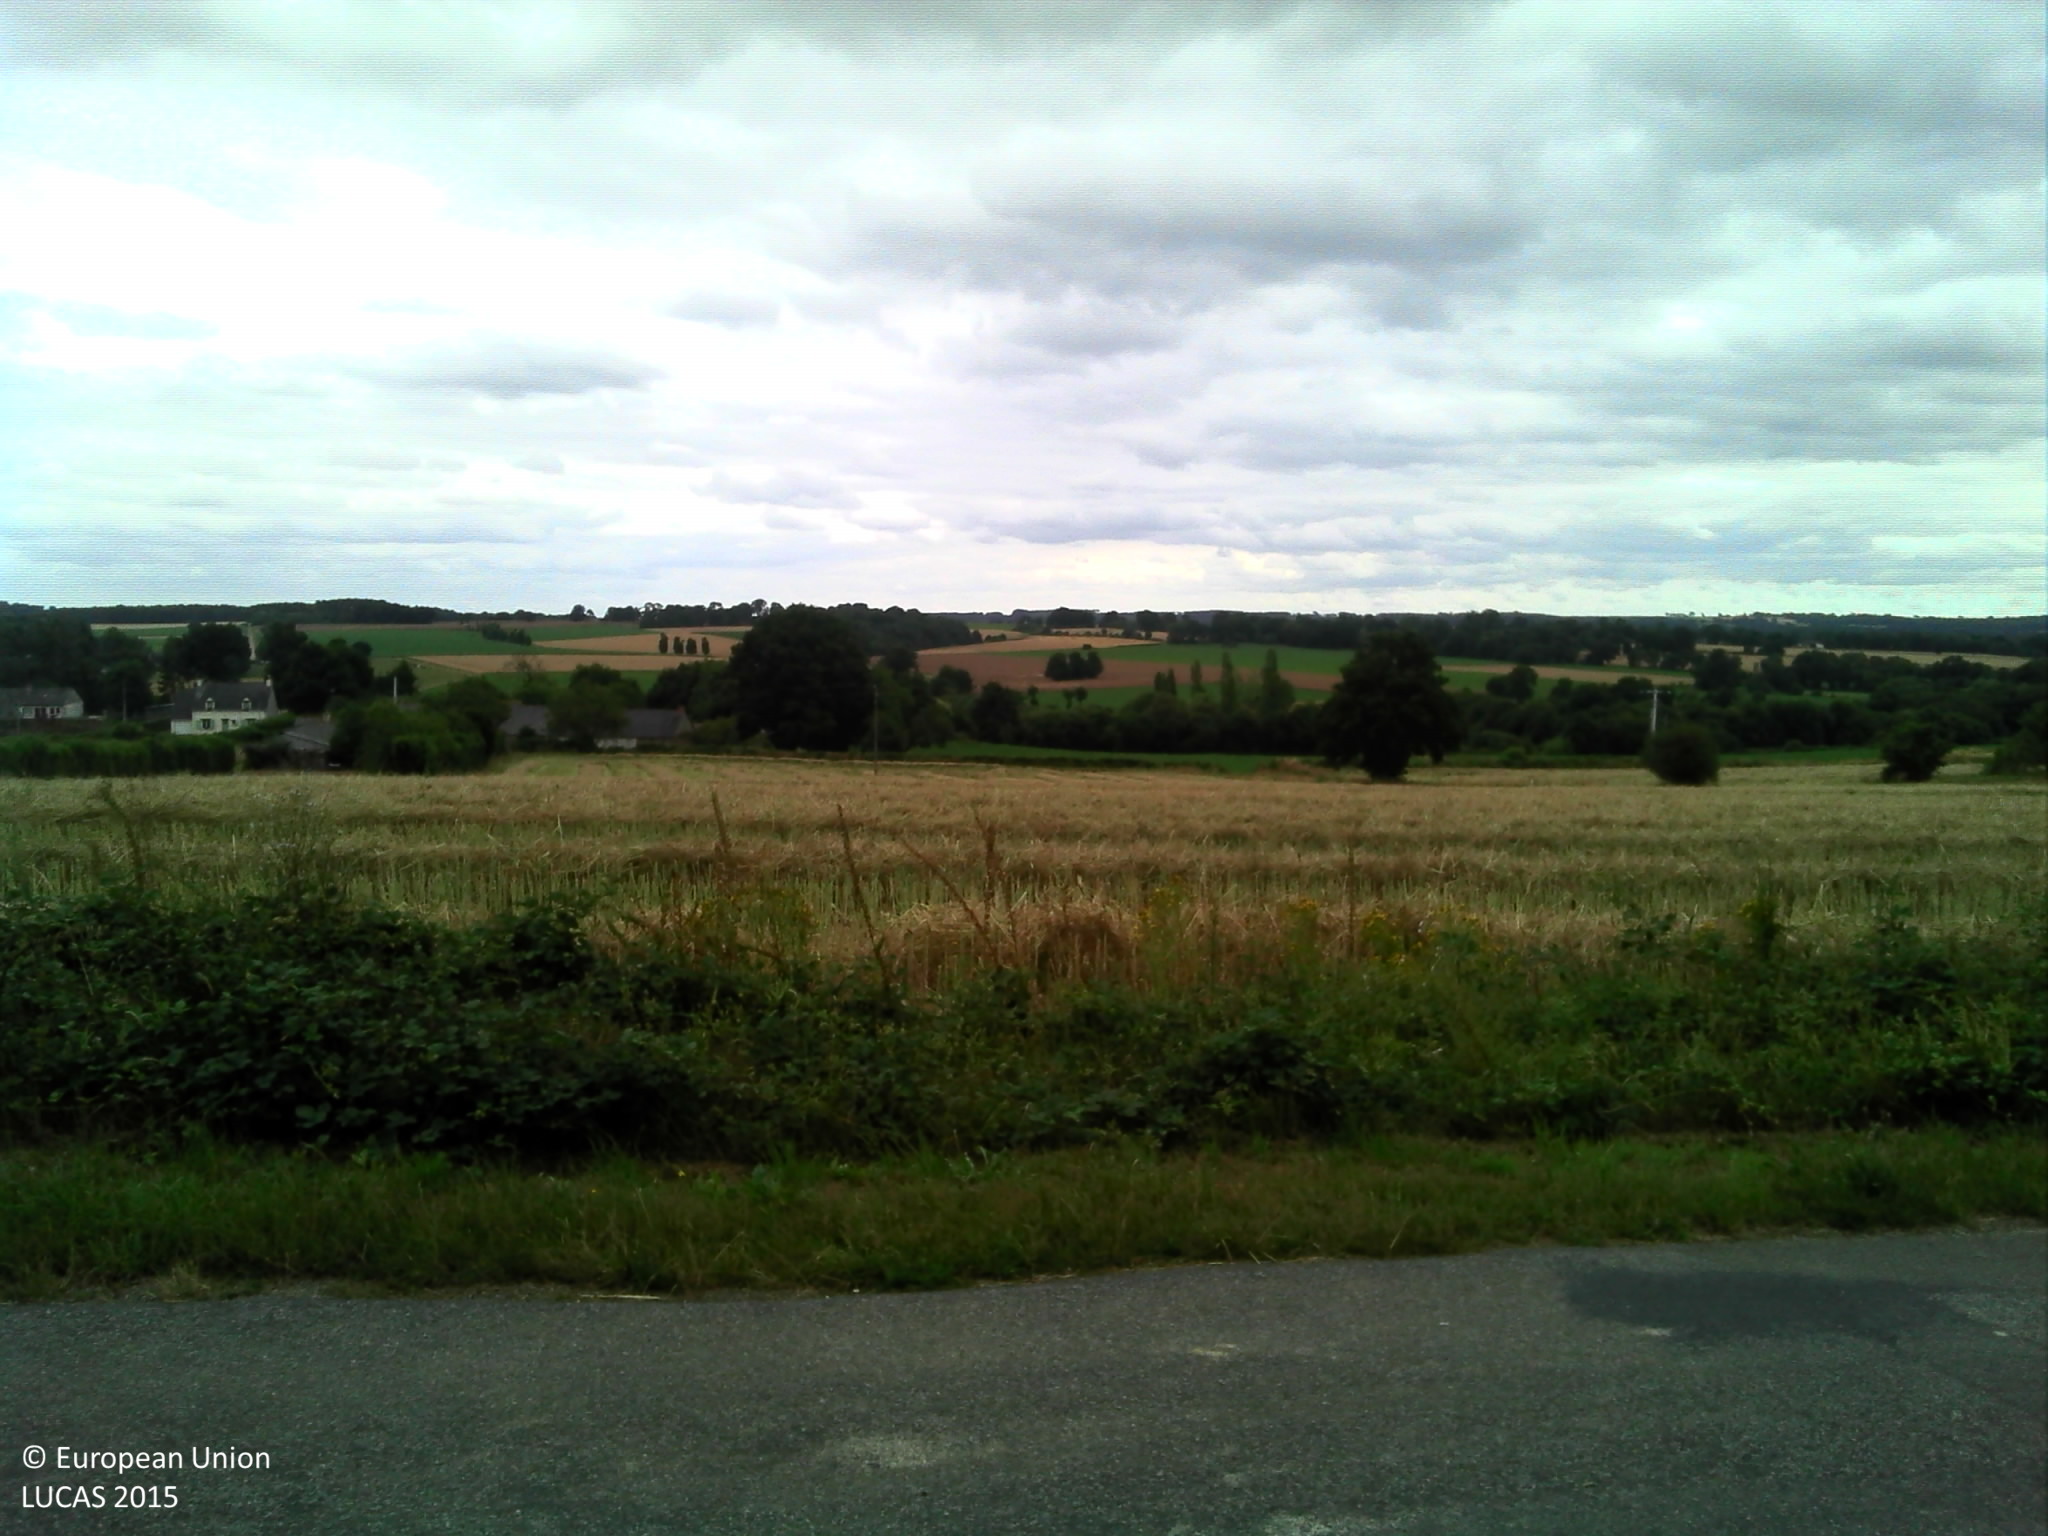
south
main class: Cropland
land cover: Apple fruit
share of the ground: 25 - 50 %
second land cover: Grassland without tree/shrub cover
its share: > 75 %
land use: Kitchen garden
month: July
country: FR
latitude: 47.8165
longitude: -2.0314
